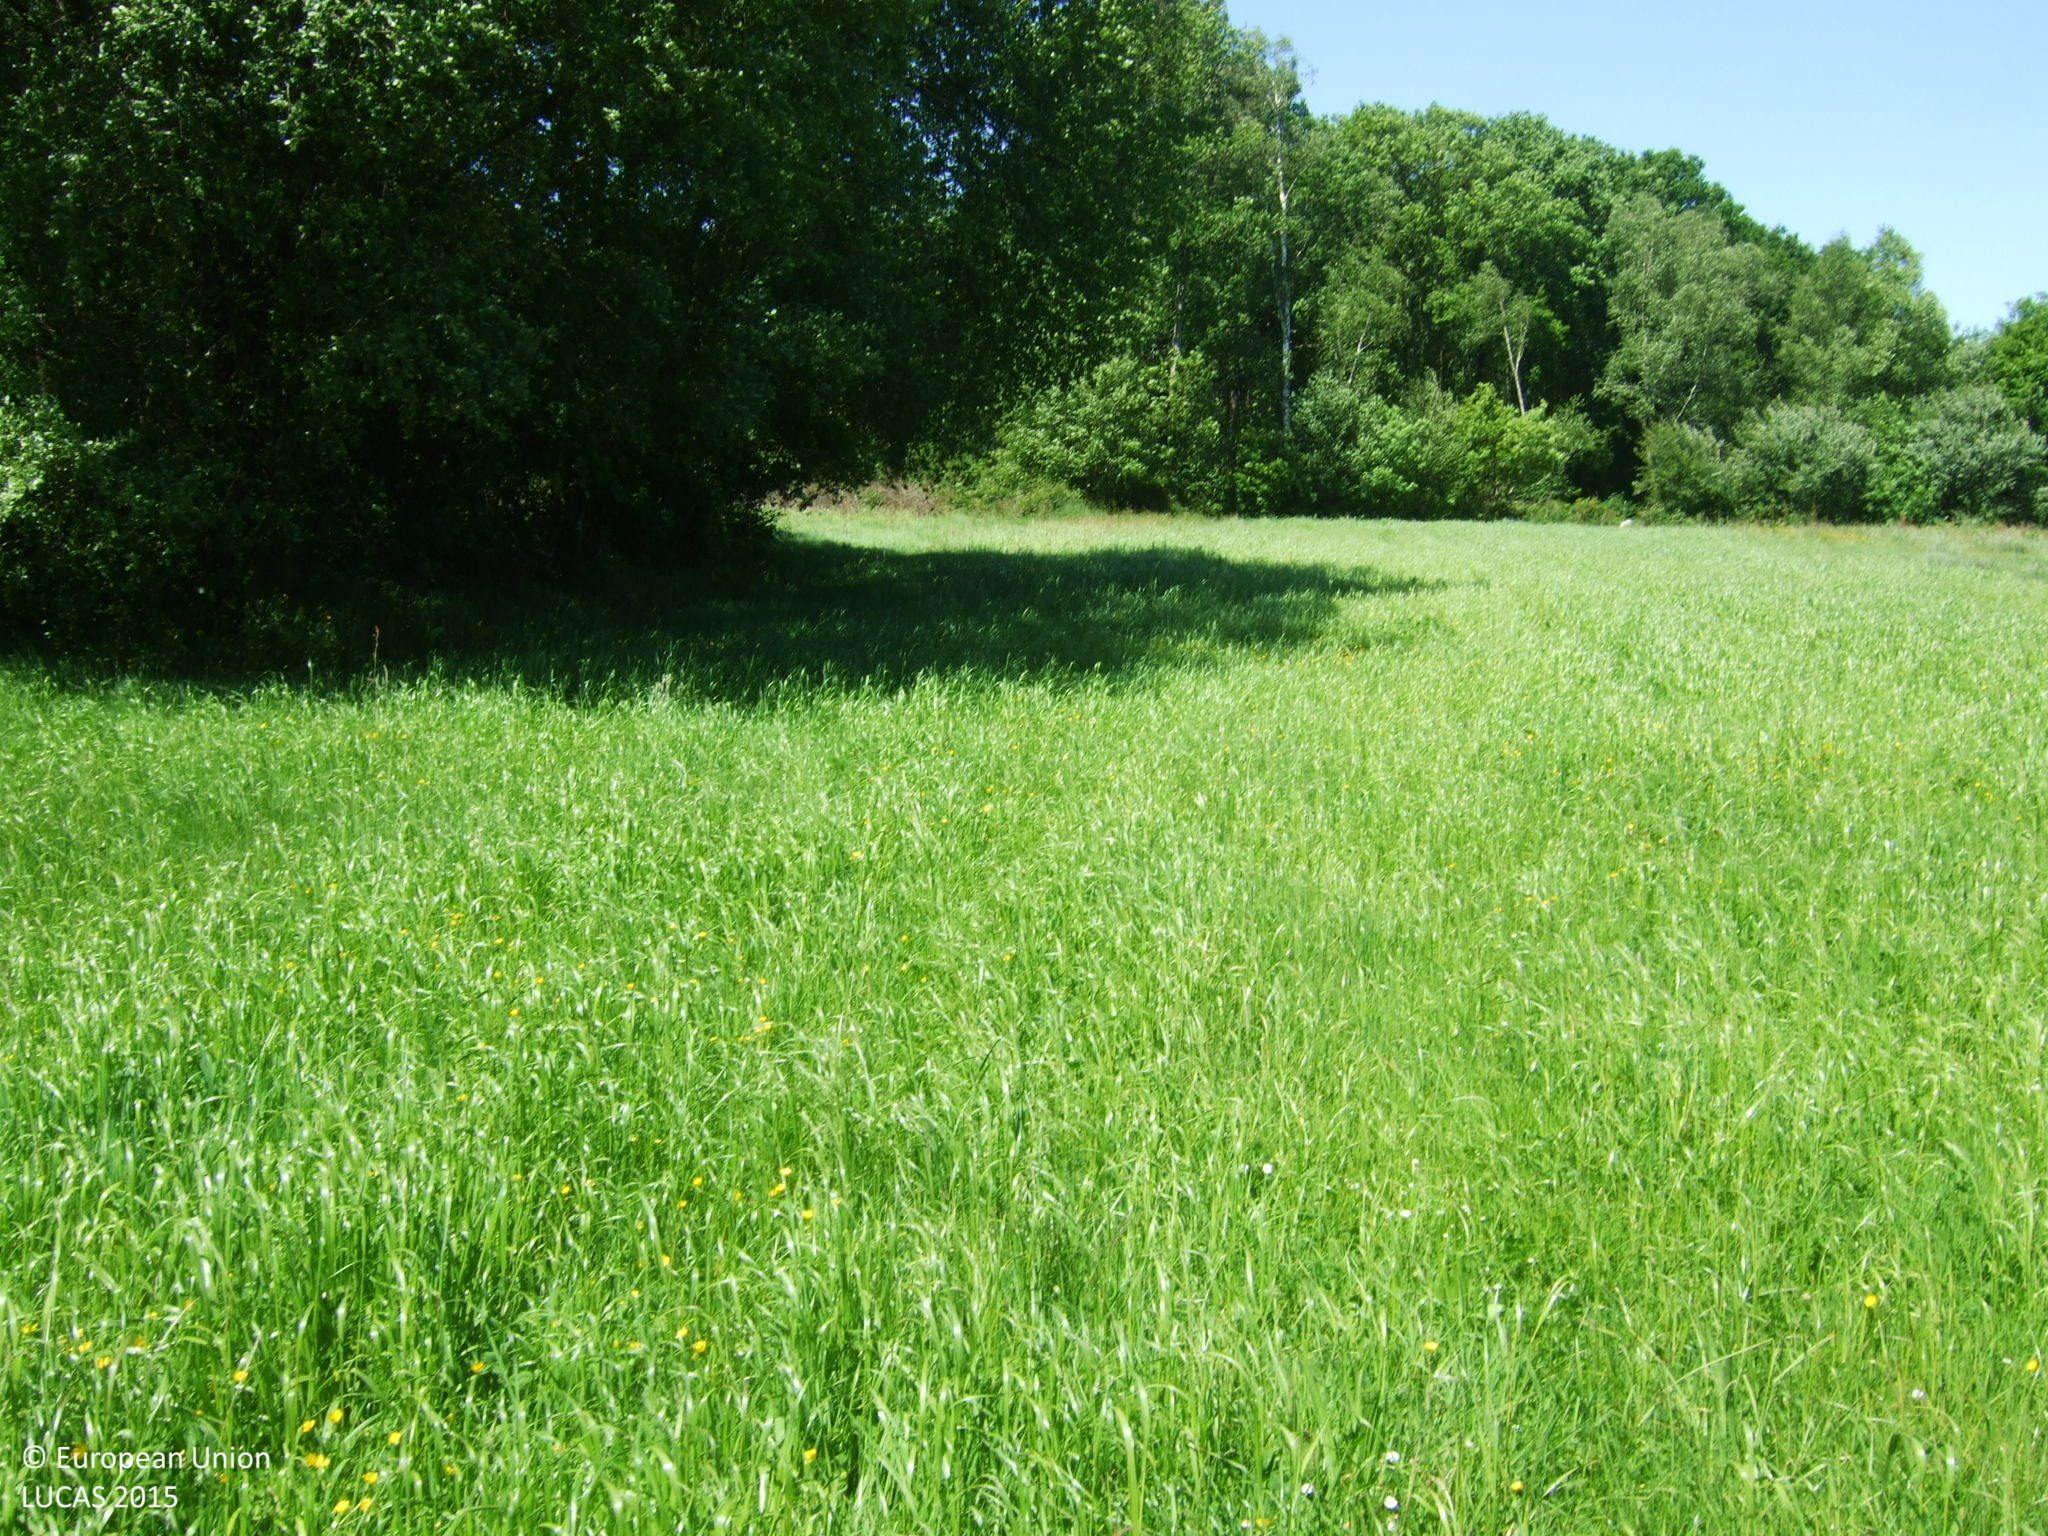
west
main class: Cropland
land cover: Temporary grasslands
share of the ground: > 75 %
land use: Agriculture (excluding fallow land and kitchen gardens)
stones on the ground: < 10 %
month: May
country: ES
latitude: 43.2153
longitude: -7.7244
